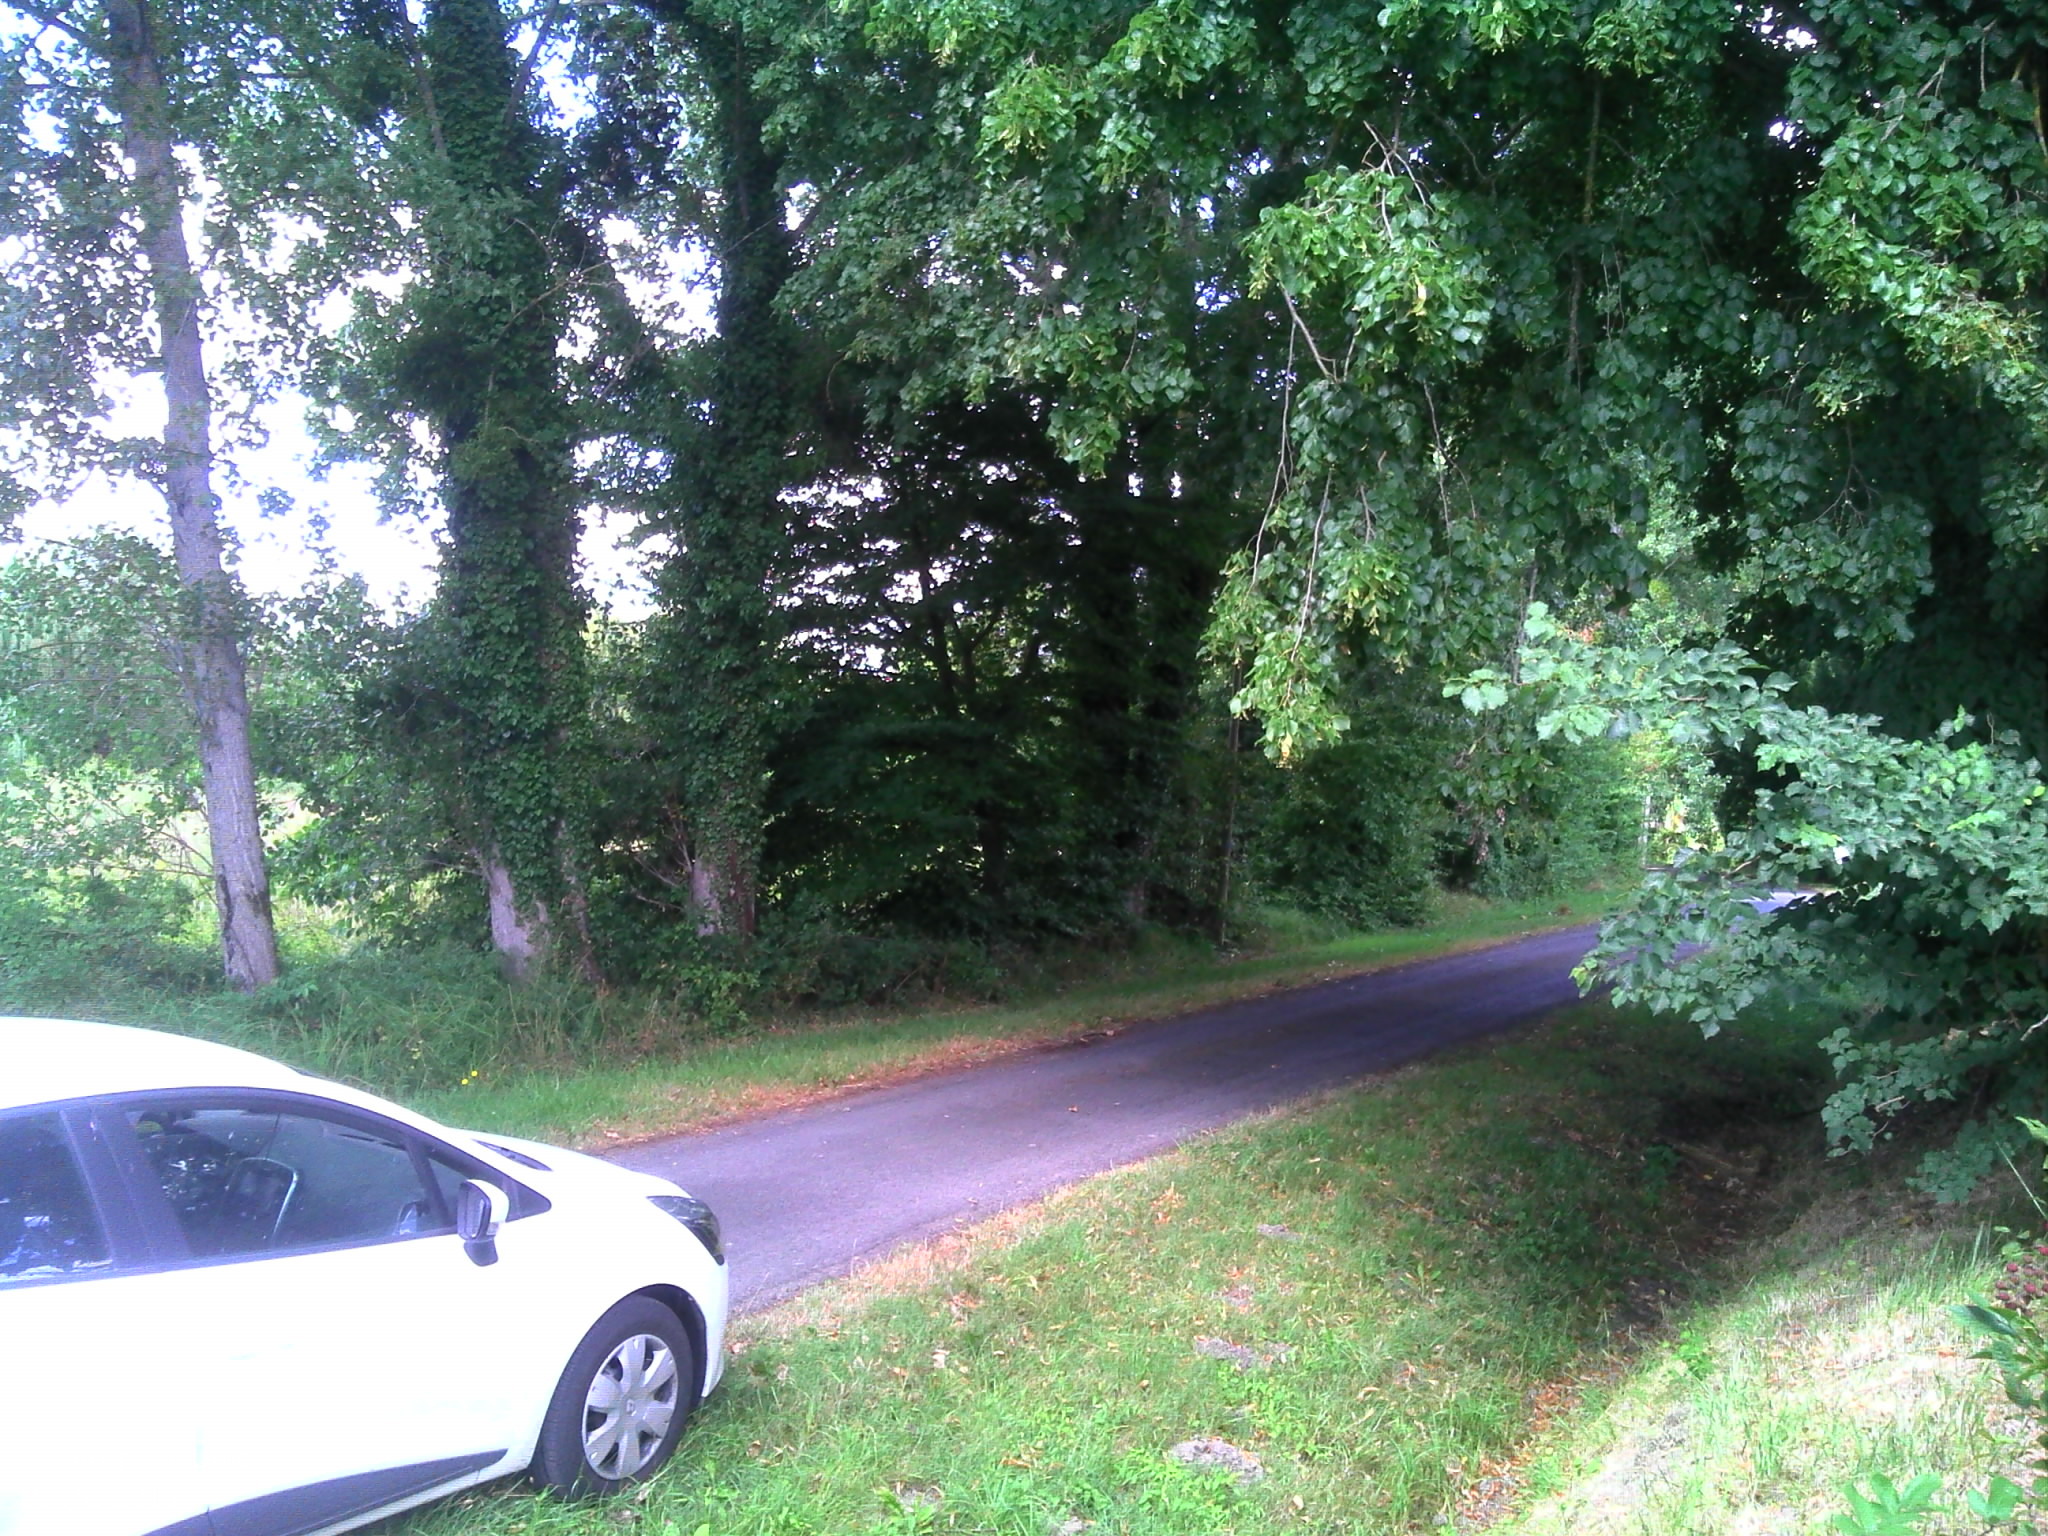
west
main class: Grassland
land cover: Grassland without tree/shrub cover
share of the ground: > 75 %
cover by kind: herbaceous plants 100 %
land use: Amenities, museums, leisure
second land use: Residential
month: July
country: FR
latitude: 47.0210
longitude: 0.3620
